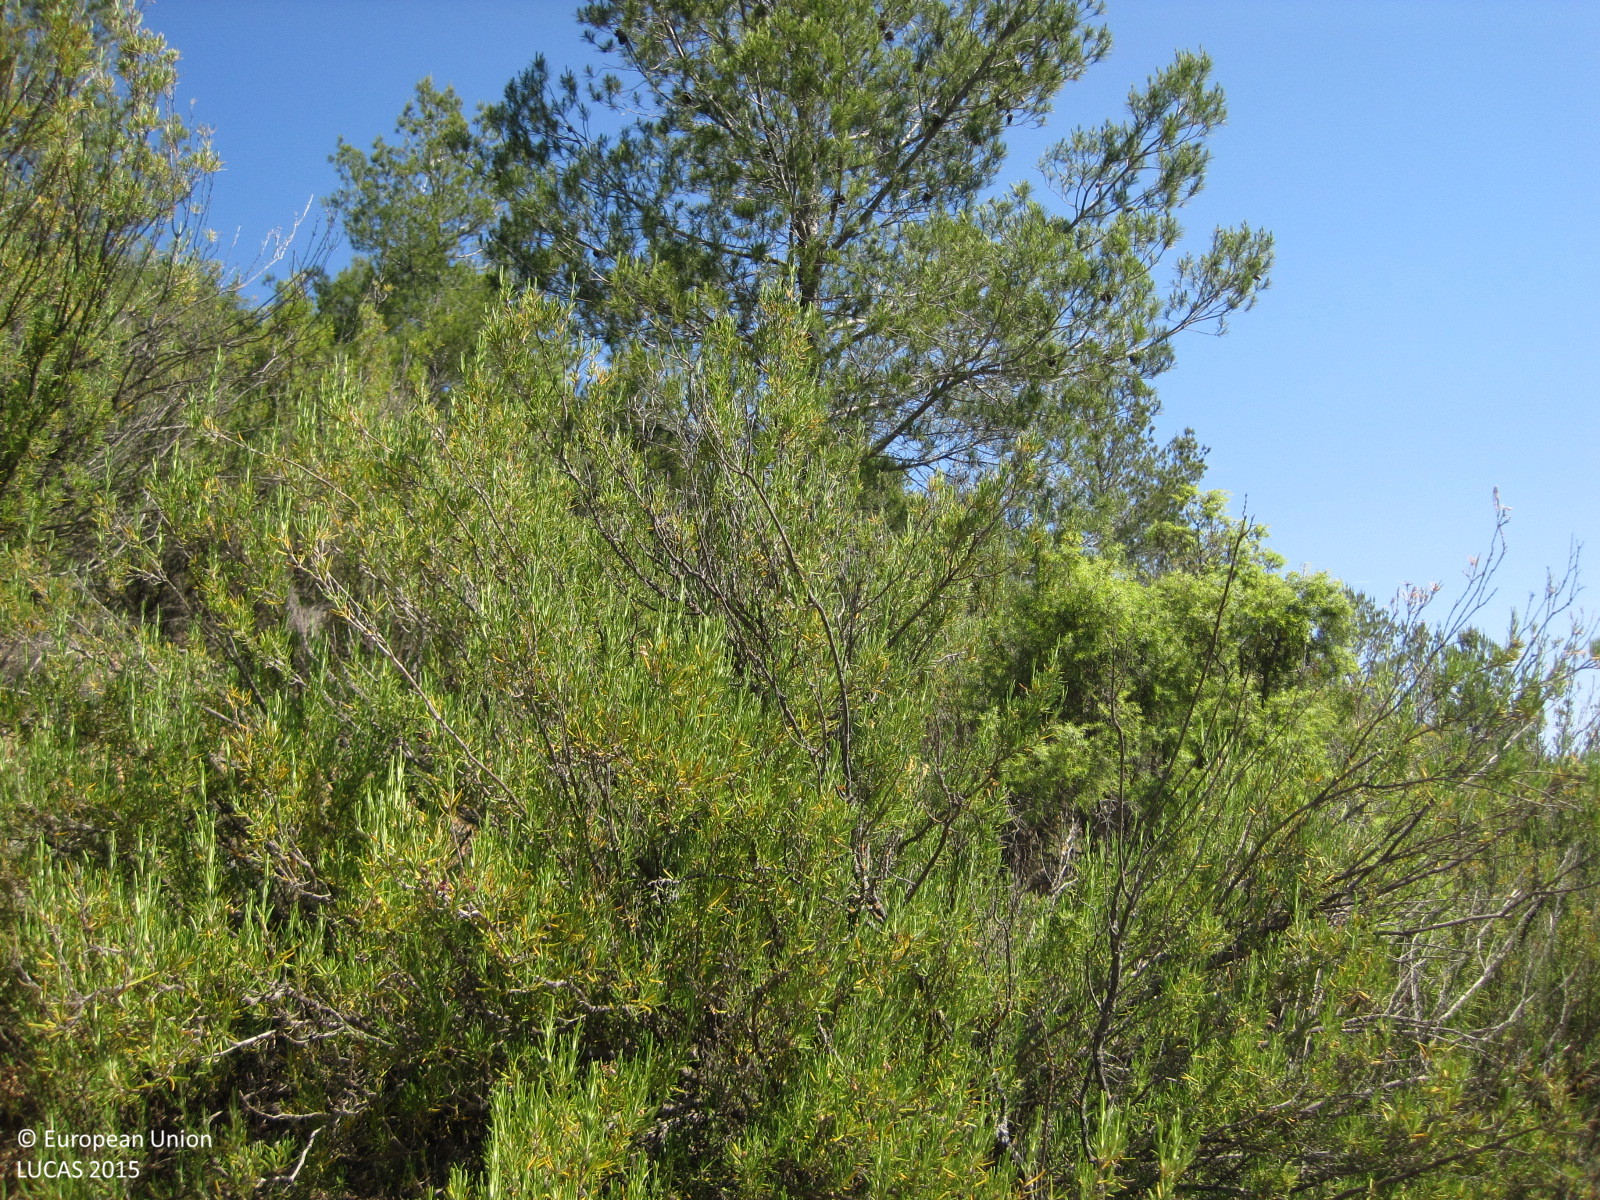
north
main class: Woodland
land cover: Pine dominated coniferous woodland
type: coniferous forest of the mediterranean region
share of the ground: 10 - 25 %
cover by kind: shrubs 50 %, unconsolidated bare surface 20 %, coniferous forest trees 15 %, herbaceous plants 15 %
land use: Forestry
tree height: > 5 m
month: June
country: ES
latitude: 39.7394
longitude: -1.1483
